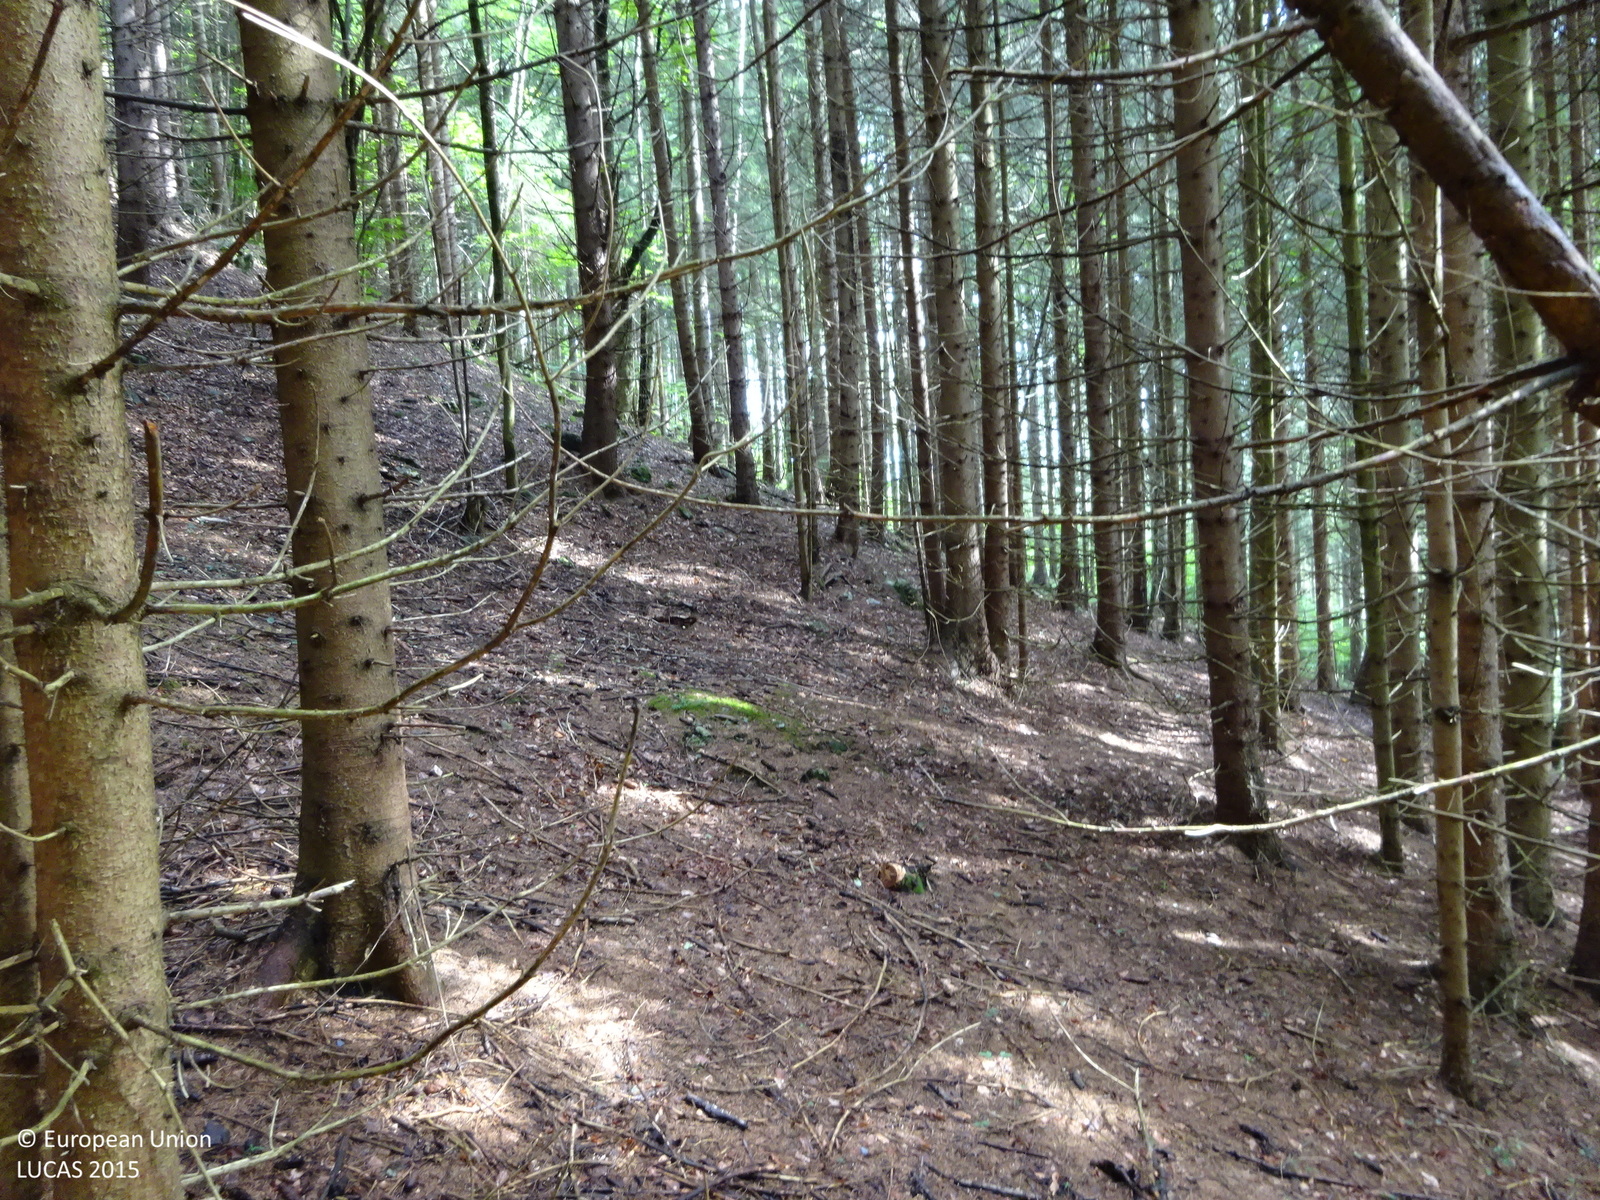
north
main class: Woodland
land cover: Spruce dominated coniferous woodland
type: alpine coniferous forest
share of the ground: > 75 %
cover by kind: coniferous forest trees 75 %, shrubs 20 %, broadleaved forest trees 5 %
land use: Forestry
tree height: > 5 m
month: July
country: AT
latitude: 47.2214
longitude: 15.4806
